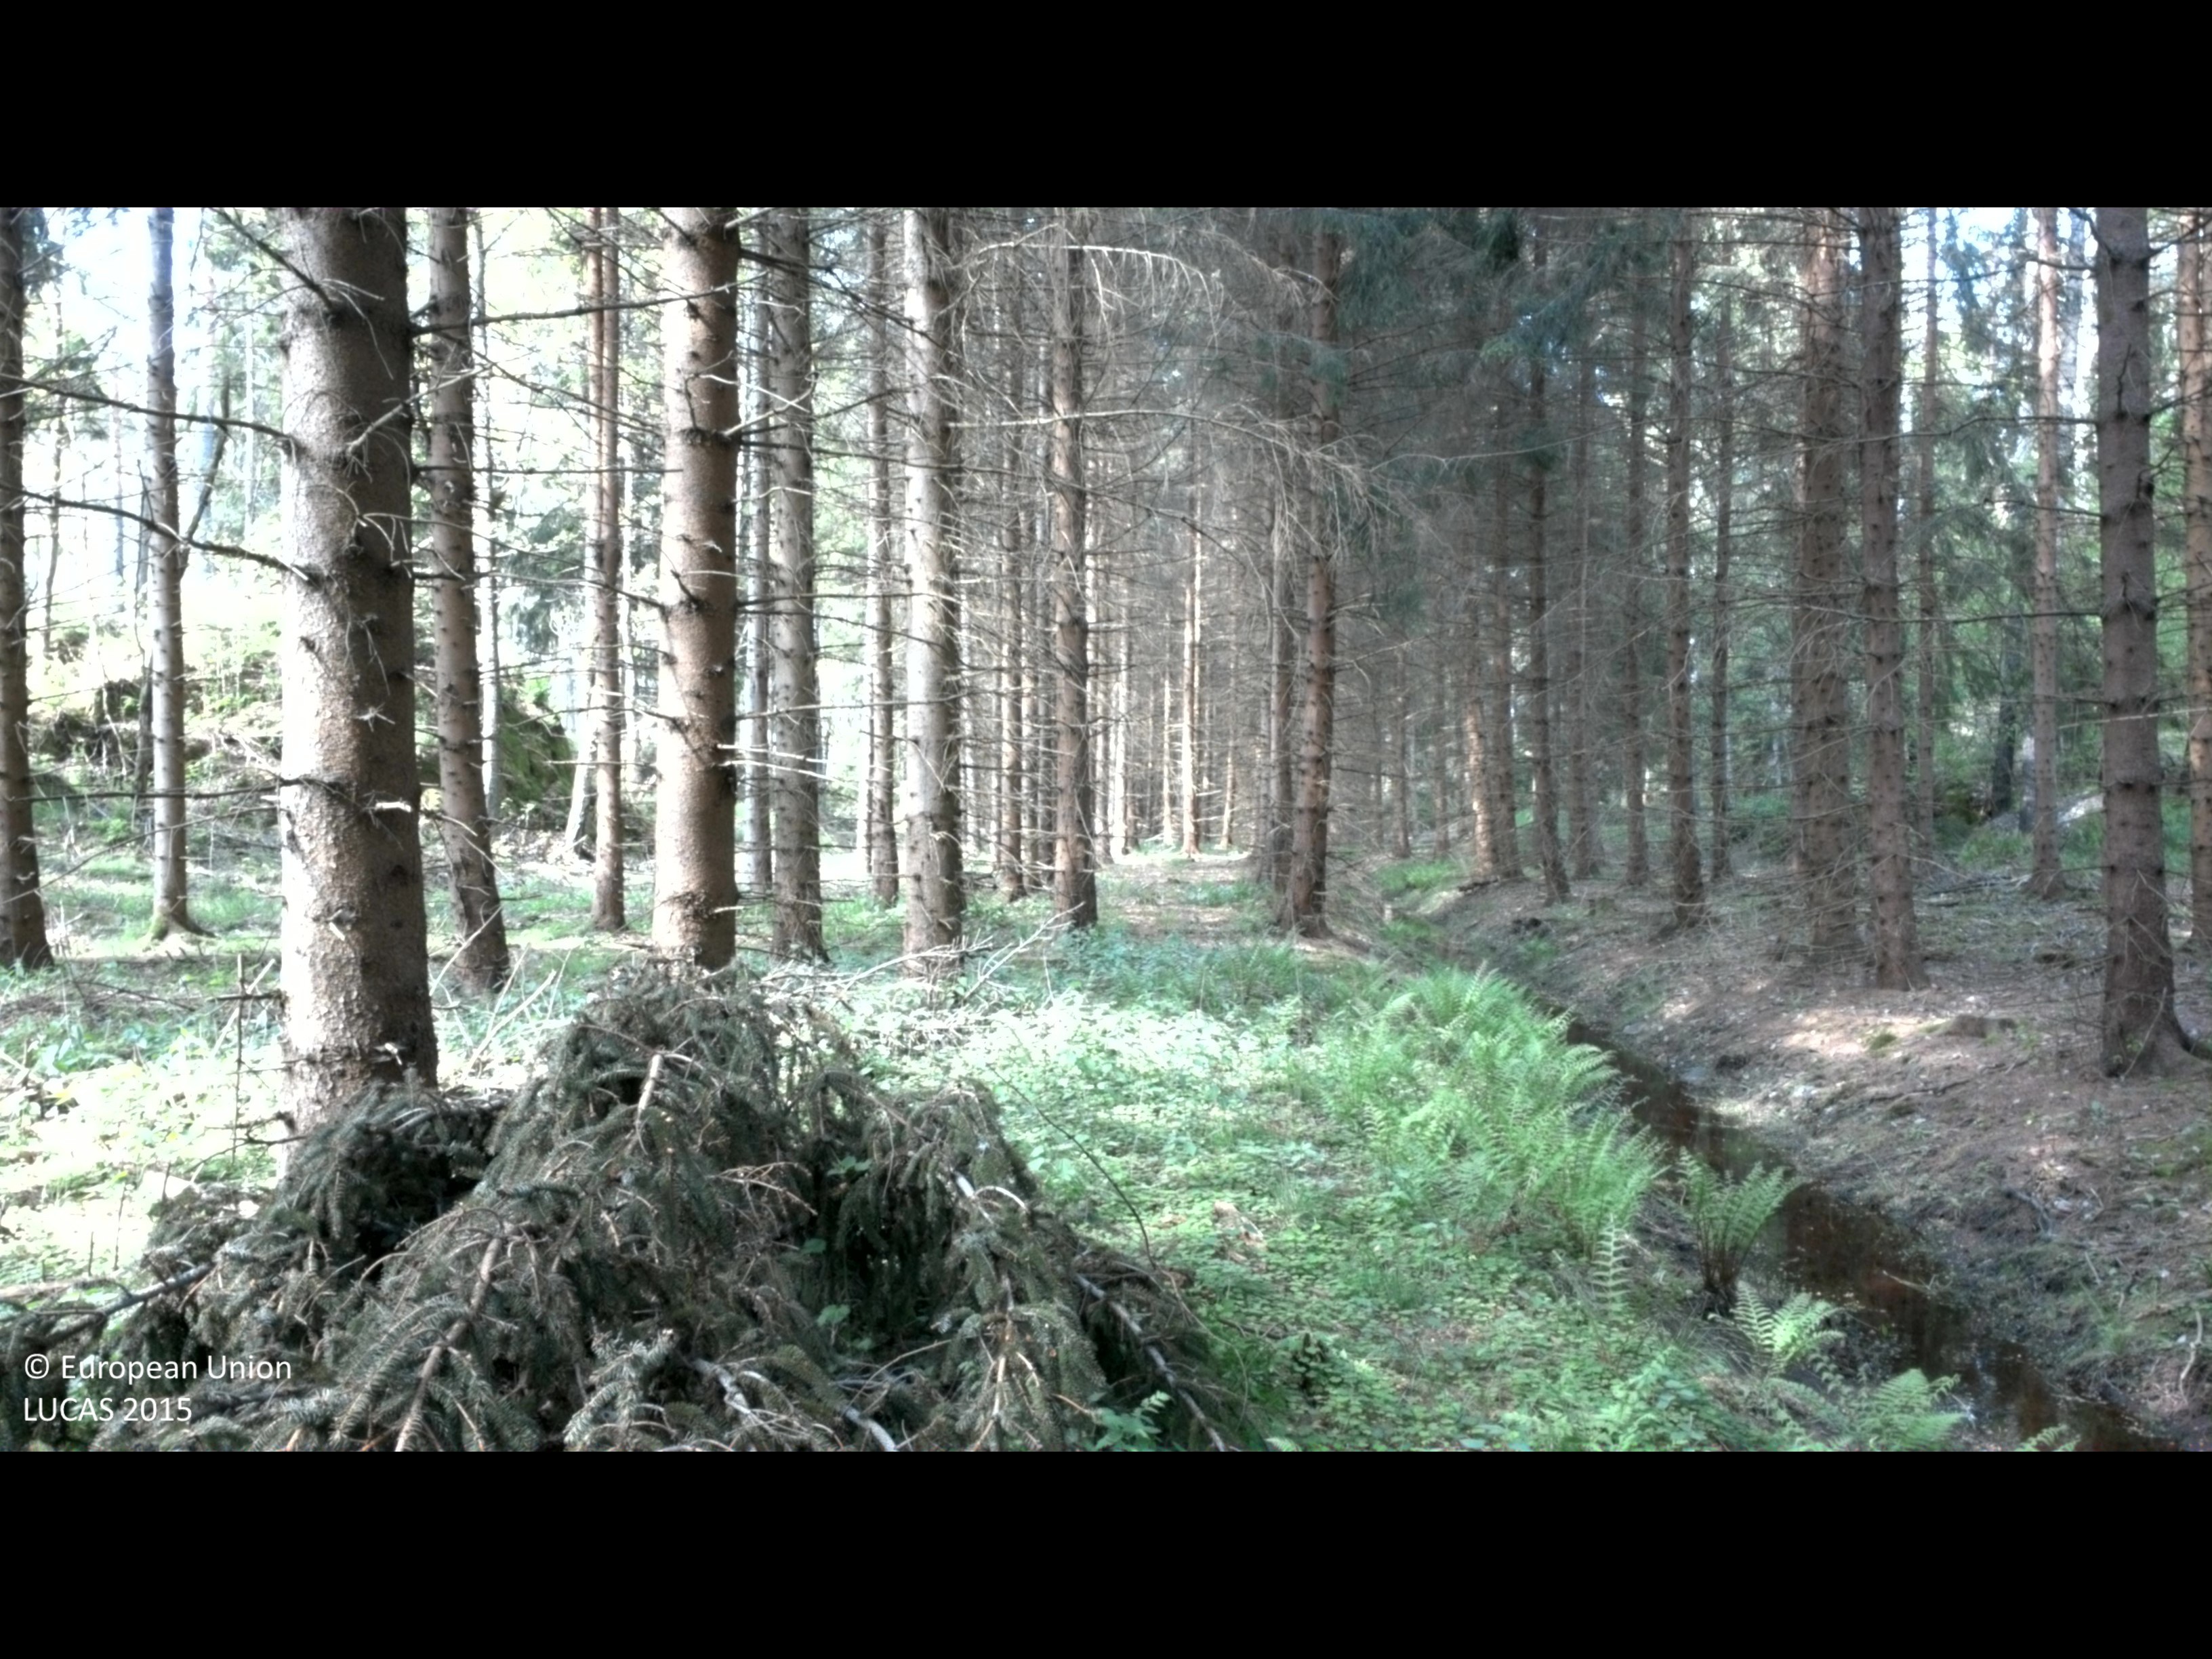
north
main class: Woodland
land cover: Spruce dominated coniferous woodland
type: boreal forest
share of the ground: > 75 %
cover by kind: coniferous forest trees 95 %, herbaceous plants 5 %
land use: Forestry
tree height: > 5 m
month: May
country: SE
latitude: 57.4087
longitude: 16.5747
